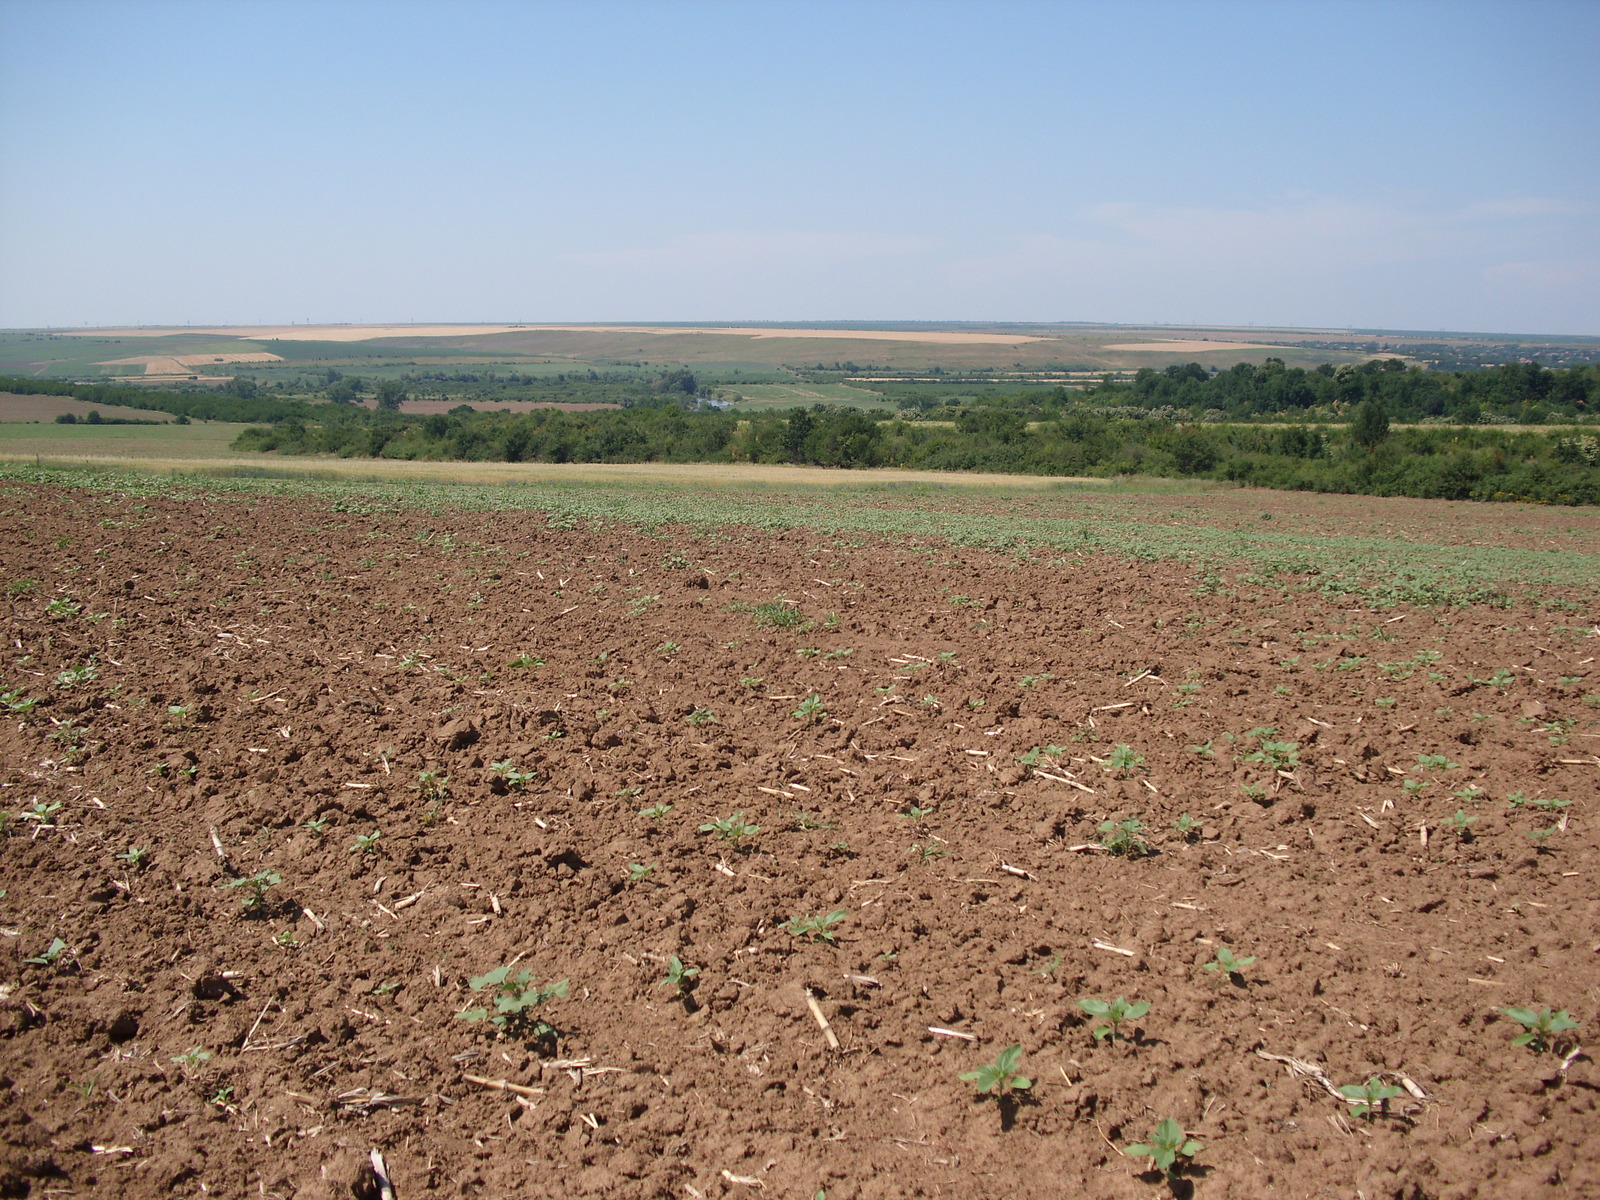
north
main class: Cropland
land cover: Sunflower
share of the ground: < 10 %
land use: Agriculture (excluding fallow land and kitchen gardens)
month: June
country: BG
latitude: 43.5420
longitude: 23.5983
